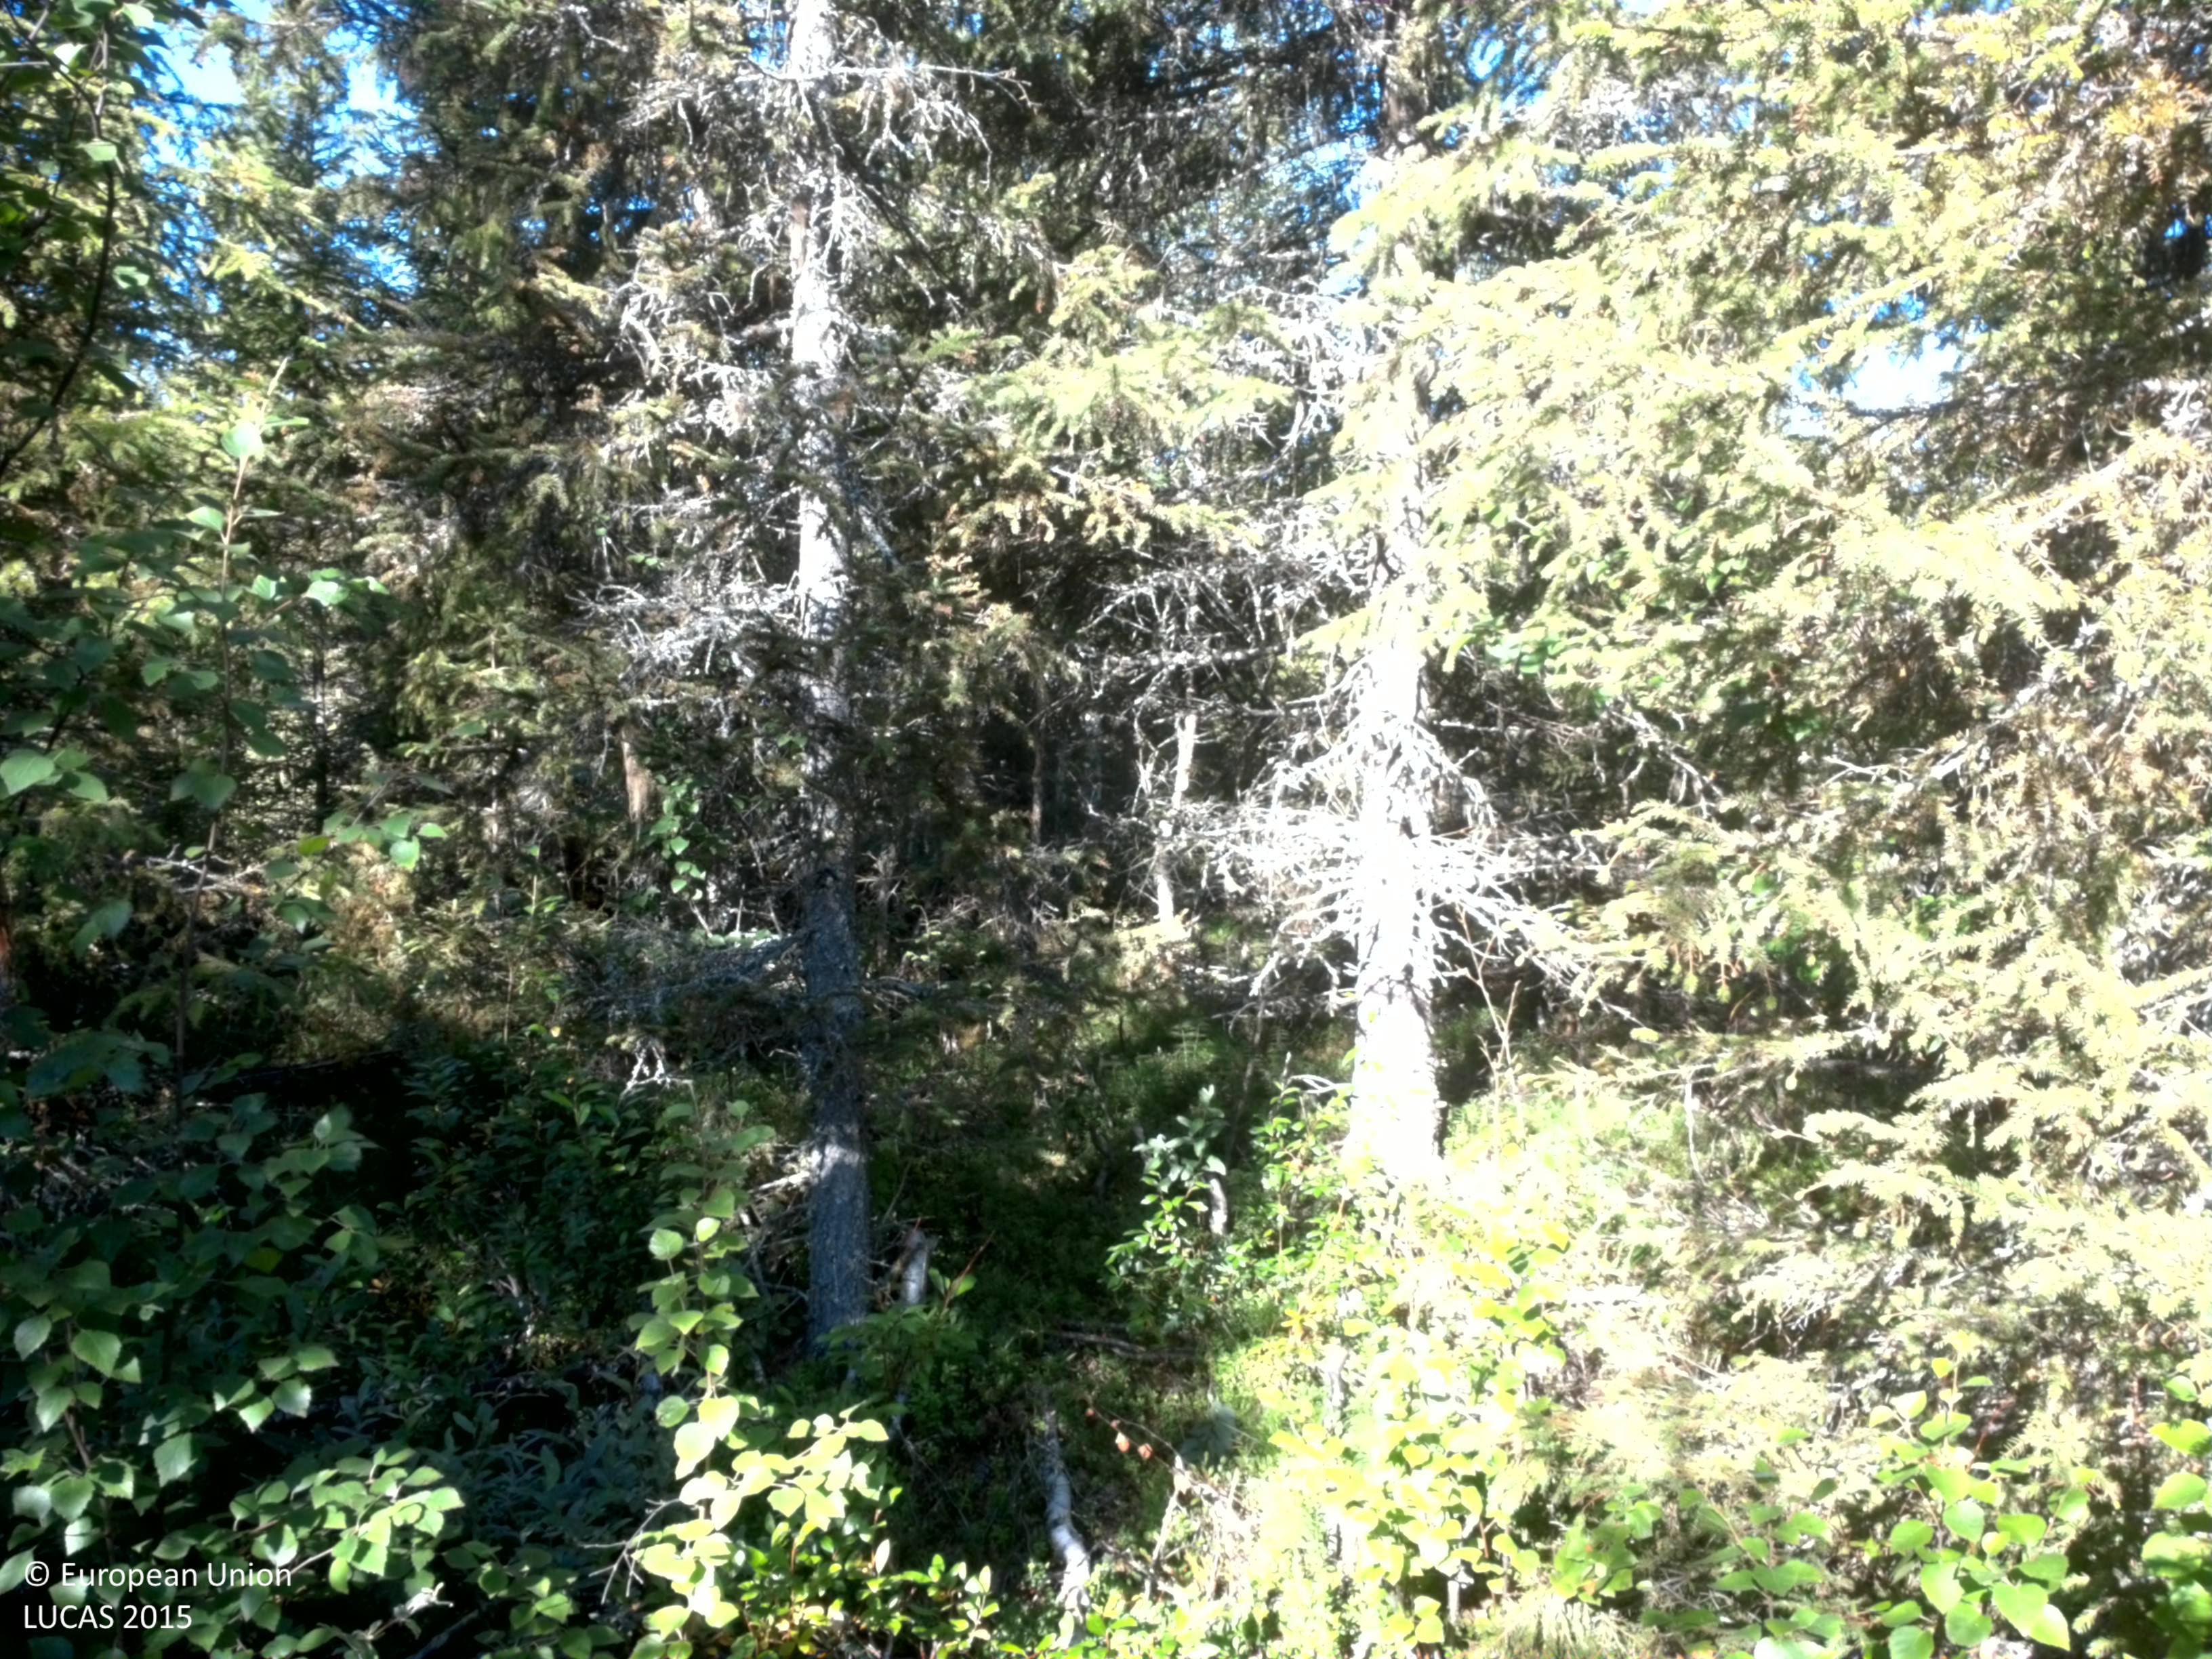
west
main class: Woodland
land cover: Spruce dominated mixed woodland
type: boreal forest
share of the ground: > 75 %
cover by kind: coniferous forest trees 60 %, broadleaved forest trees 20 %, shrubs 15 %, lichens and mosses 5 %
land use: Forestry
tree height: > 5 m
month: August
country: SE
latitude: 64.4468
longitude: 18.4253
